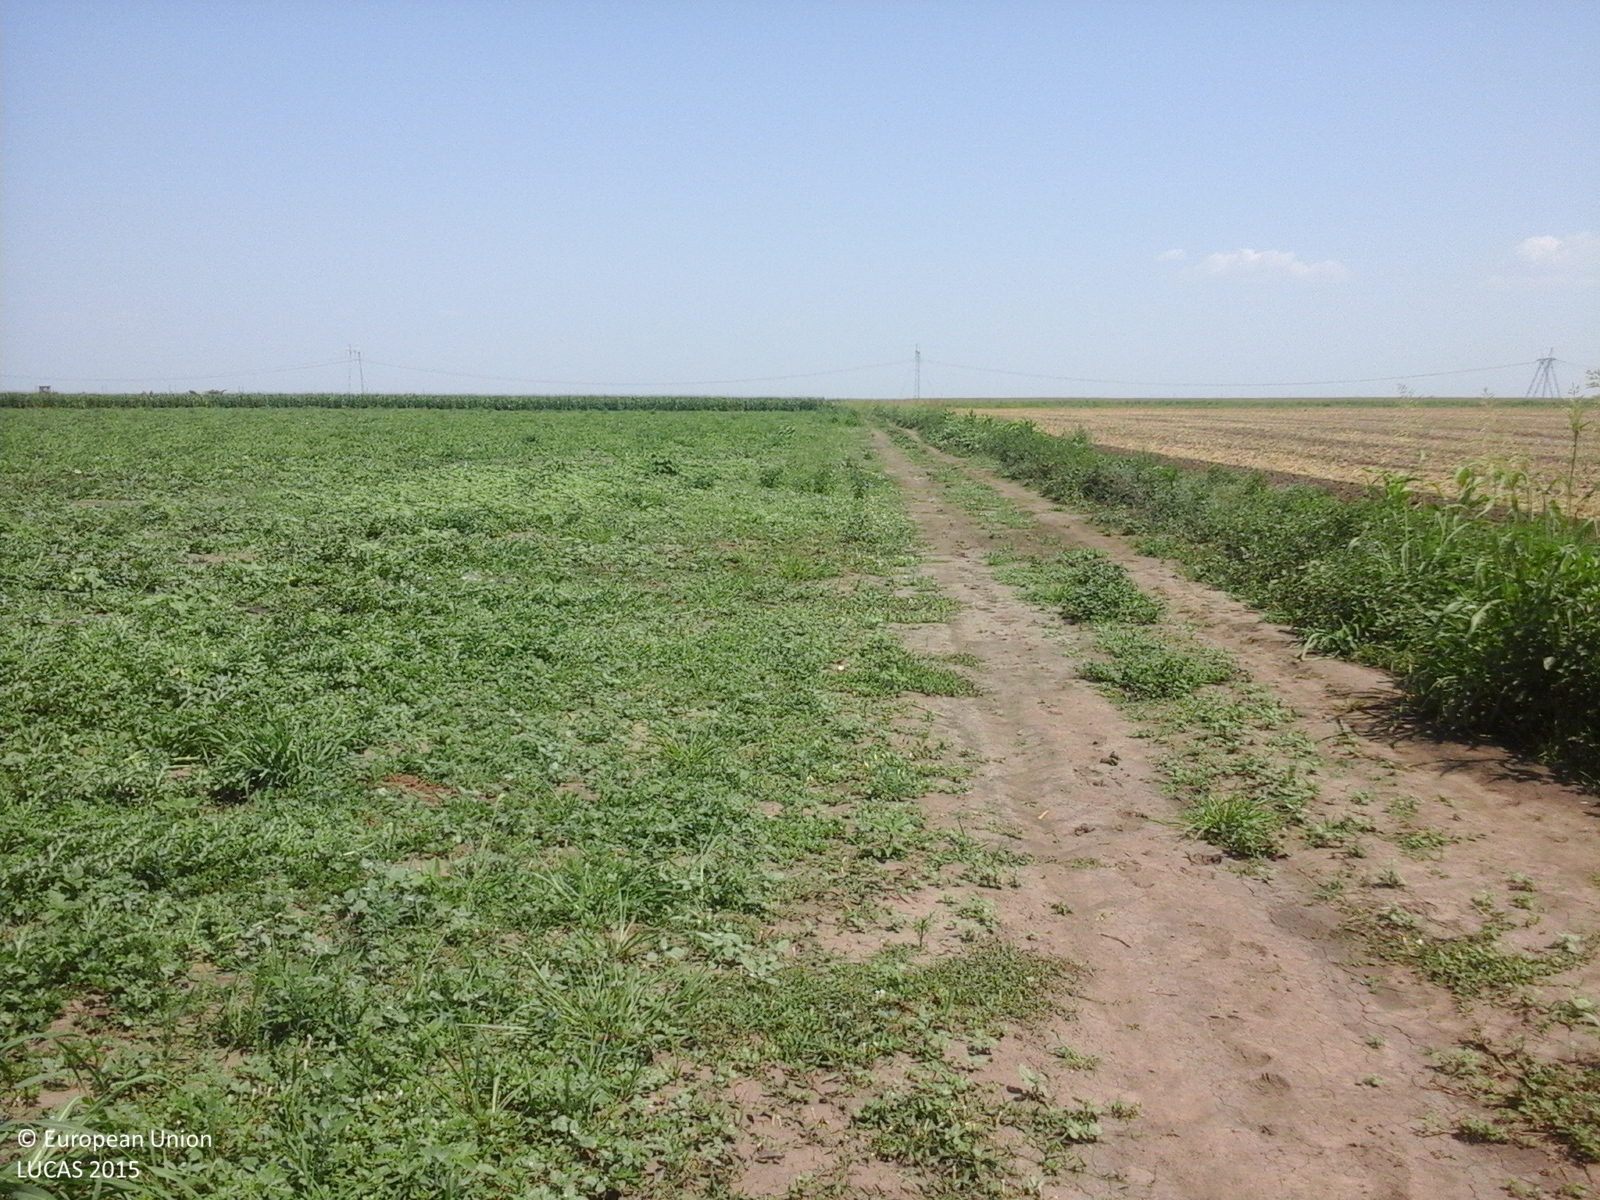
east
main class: Cropland
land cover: Other fresh vegetables
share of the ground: > 75 %
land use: Agriculture (excluding fallow land and kitchen gardens)
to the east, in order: Other fresh vegetables; Maize; Spontaneously vegetated surfaces; Tracks; Spontaneously vegetated surfaces
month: July
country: RO
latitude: 44.7584
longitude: 27.6467
